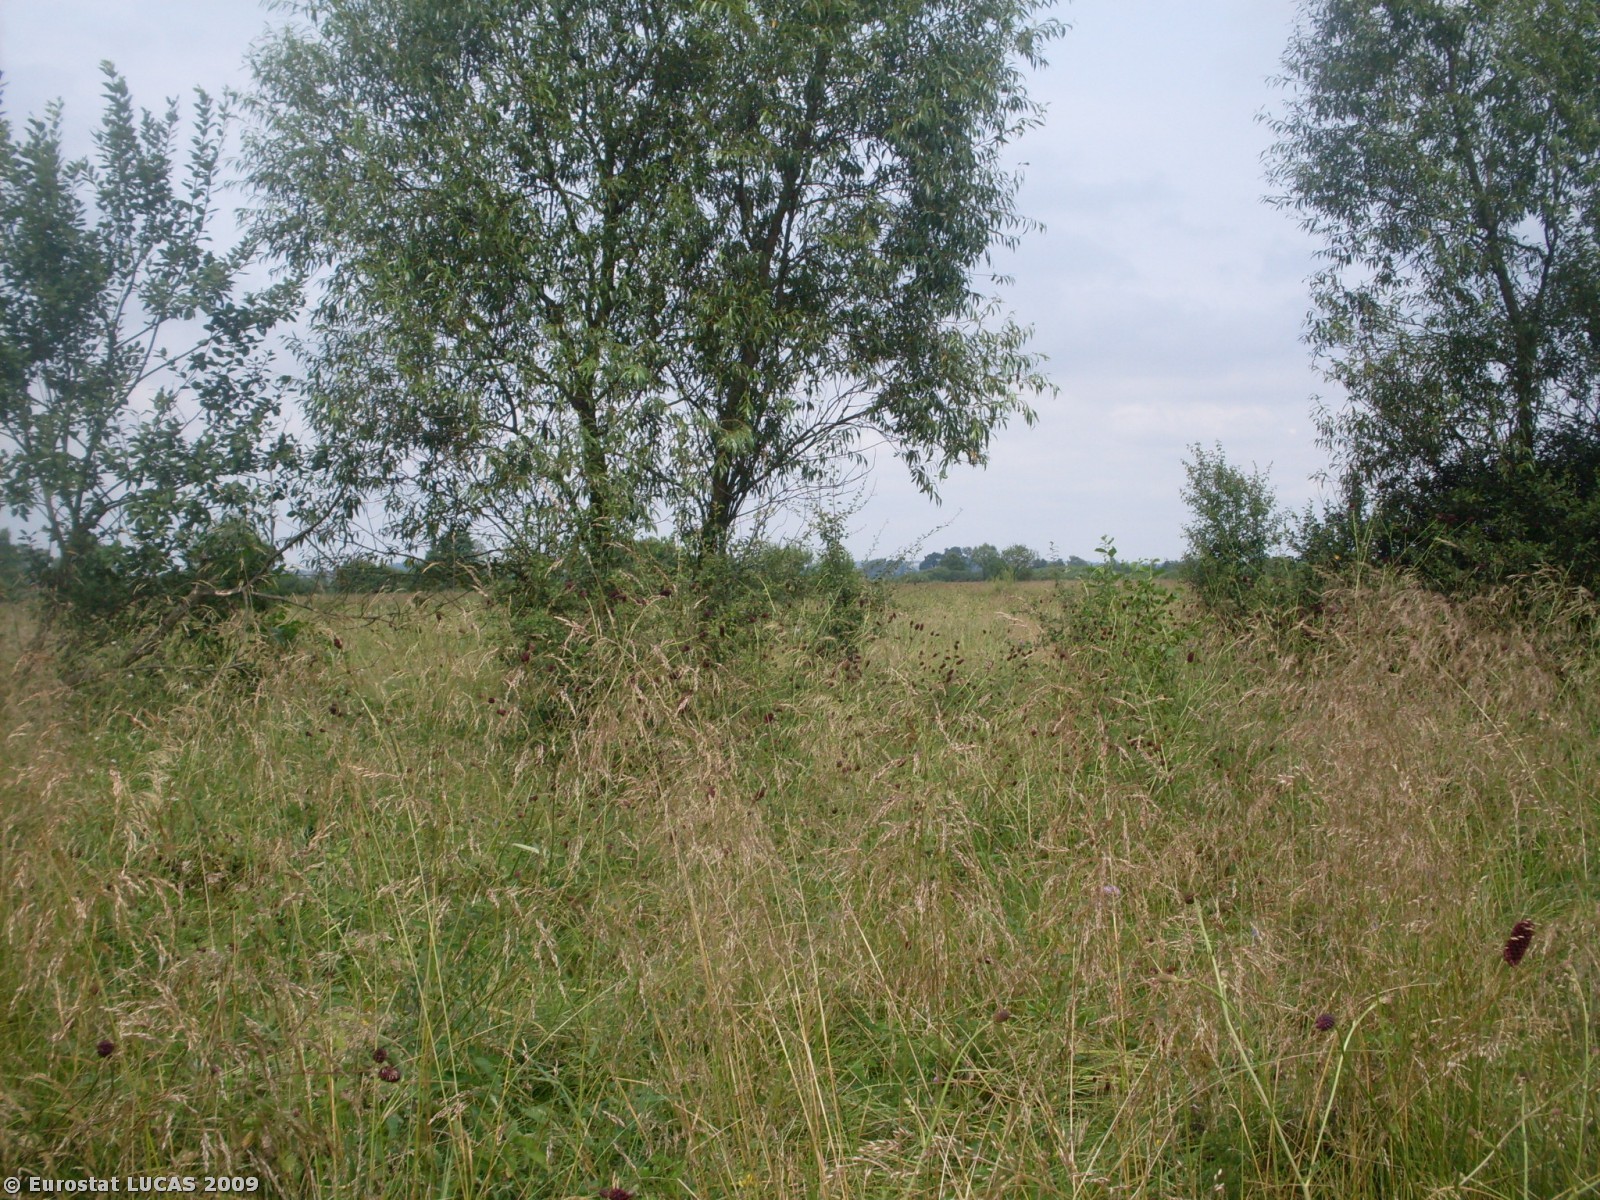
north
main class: Grassland
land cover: Grassland without tree/shrub cover
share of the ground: > 75 %
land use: Agriculture (excluding fallow land and kitchen gardens)
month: August
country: PL
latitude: 50.1089
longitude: 20.5675
